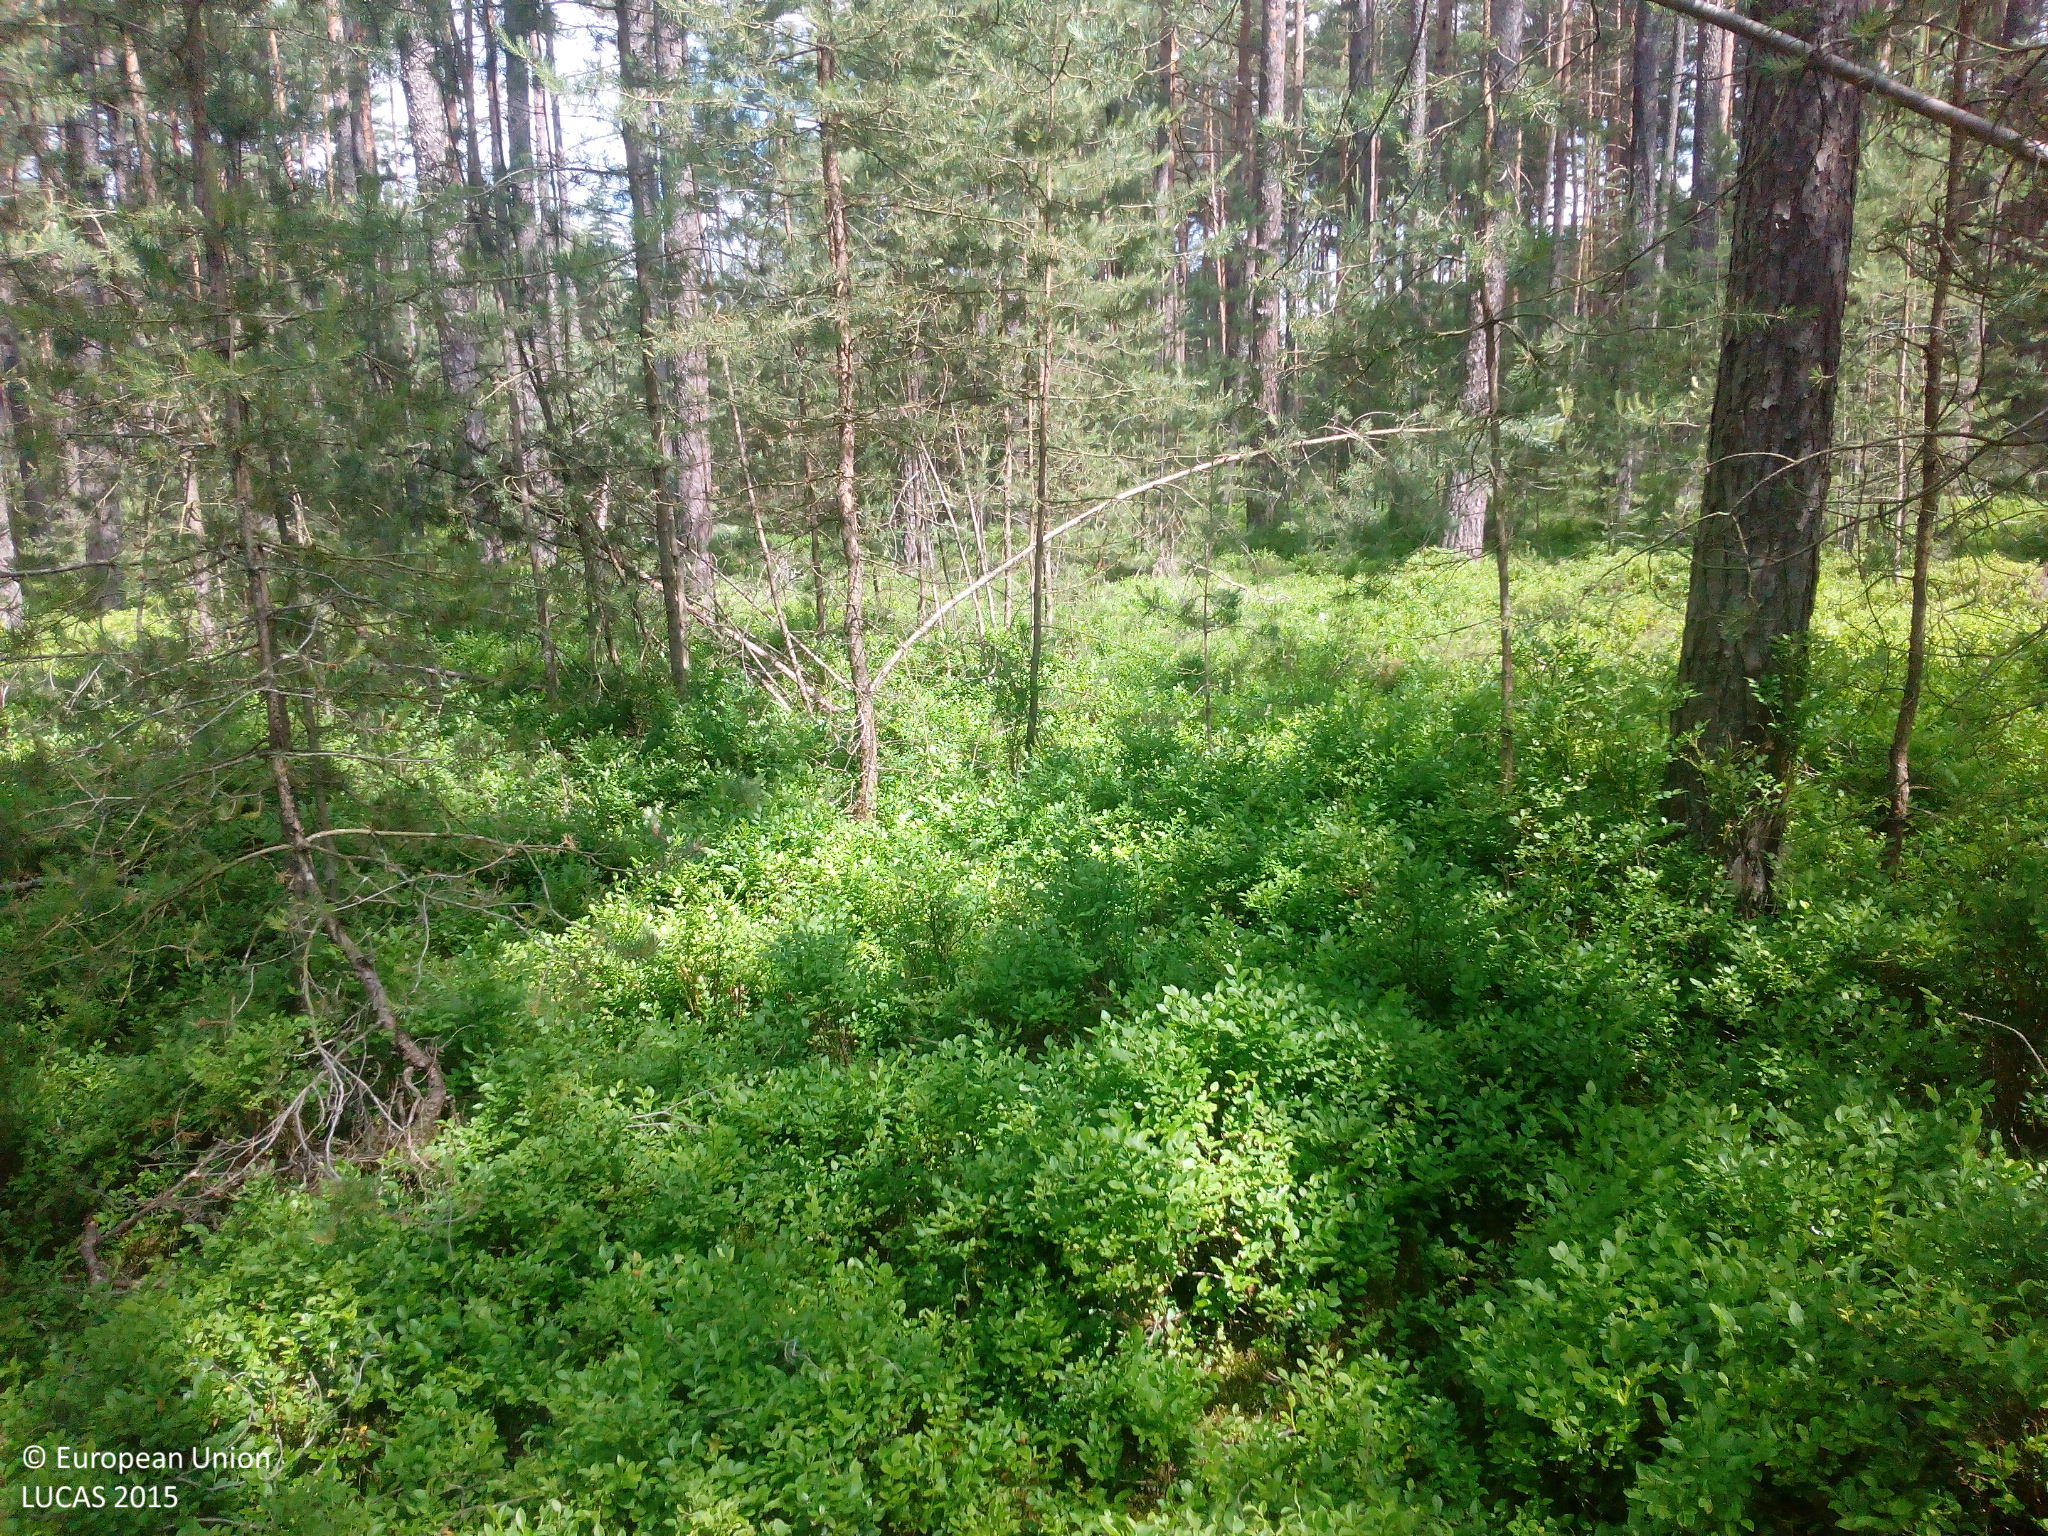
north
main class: Woodland
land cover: Pine dominated coniferous woodland
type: hemiboreal forest and nemoral coniferous forest and mixed broadleaved-coniferous forest
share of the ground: > 75 %
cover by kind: coniferous forest trees 75 %, shrubs 20 %, herbaceous plants 5 %
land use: Forestry
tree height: > 5 m
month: June
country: DE
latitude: 49.2453
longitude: 10.9200
